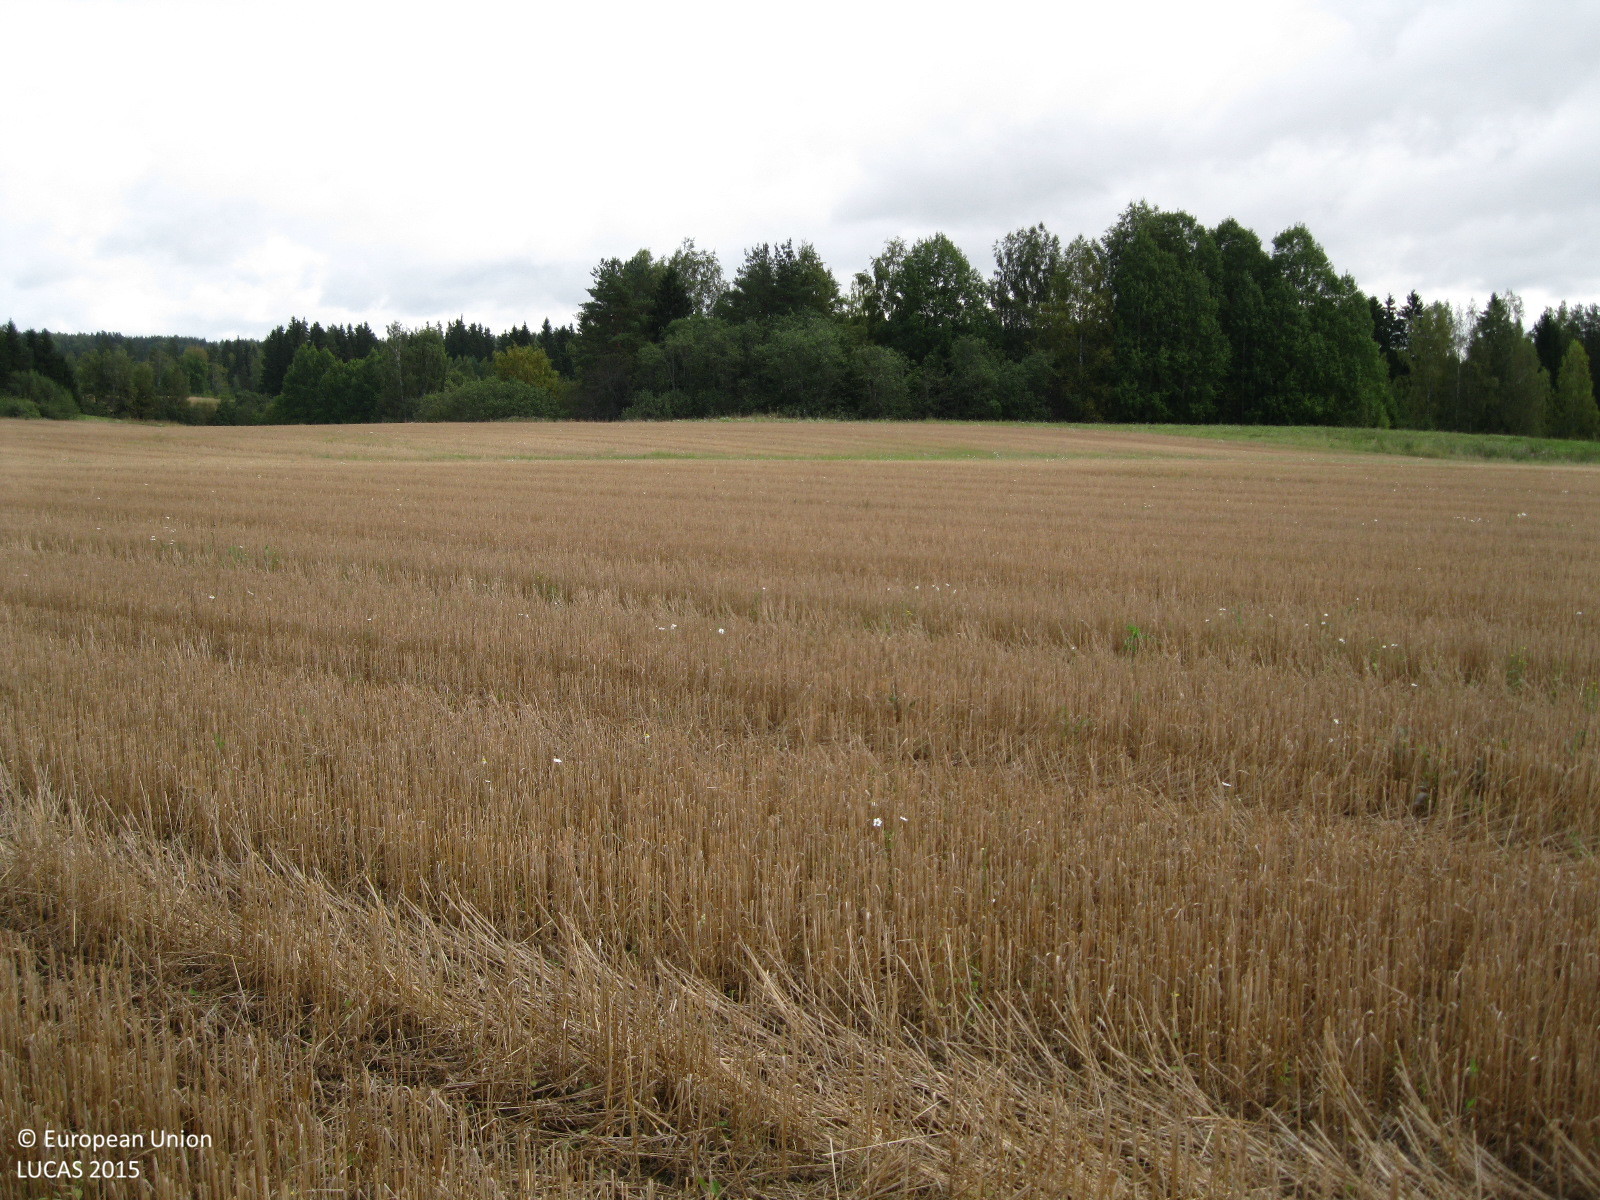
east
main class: Cropland
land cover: Common wheat
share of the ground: > 75 %
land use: Agriculture (excluding fallow land and kitchen gardens)
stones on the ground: < 10 %
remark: Harvested field
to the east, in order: Common wheat; Spontaneously vegetated surfaces; Broadleaved woodland; Inland marshes; Inland fresh running water; Broadleaved woodland; Grassland without tree/shrub cover
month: September
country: FI
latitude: 60.4353
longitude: 24.8498
